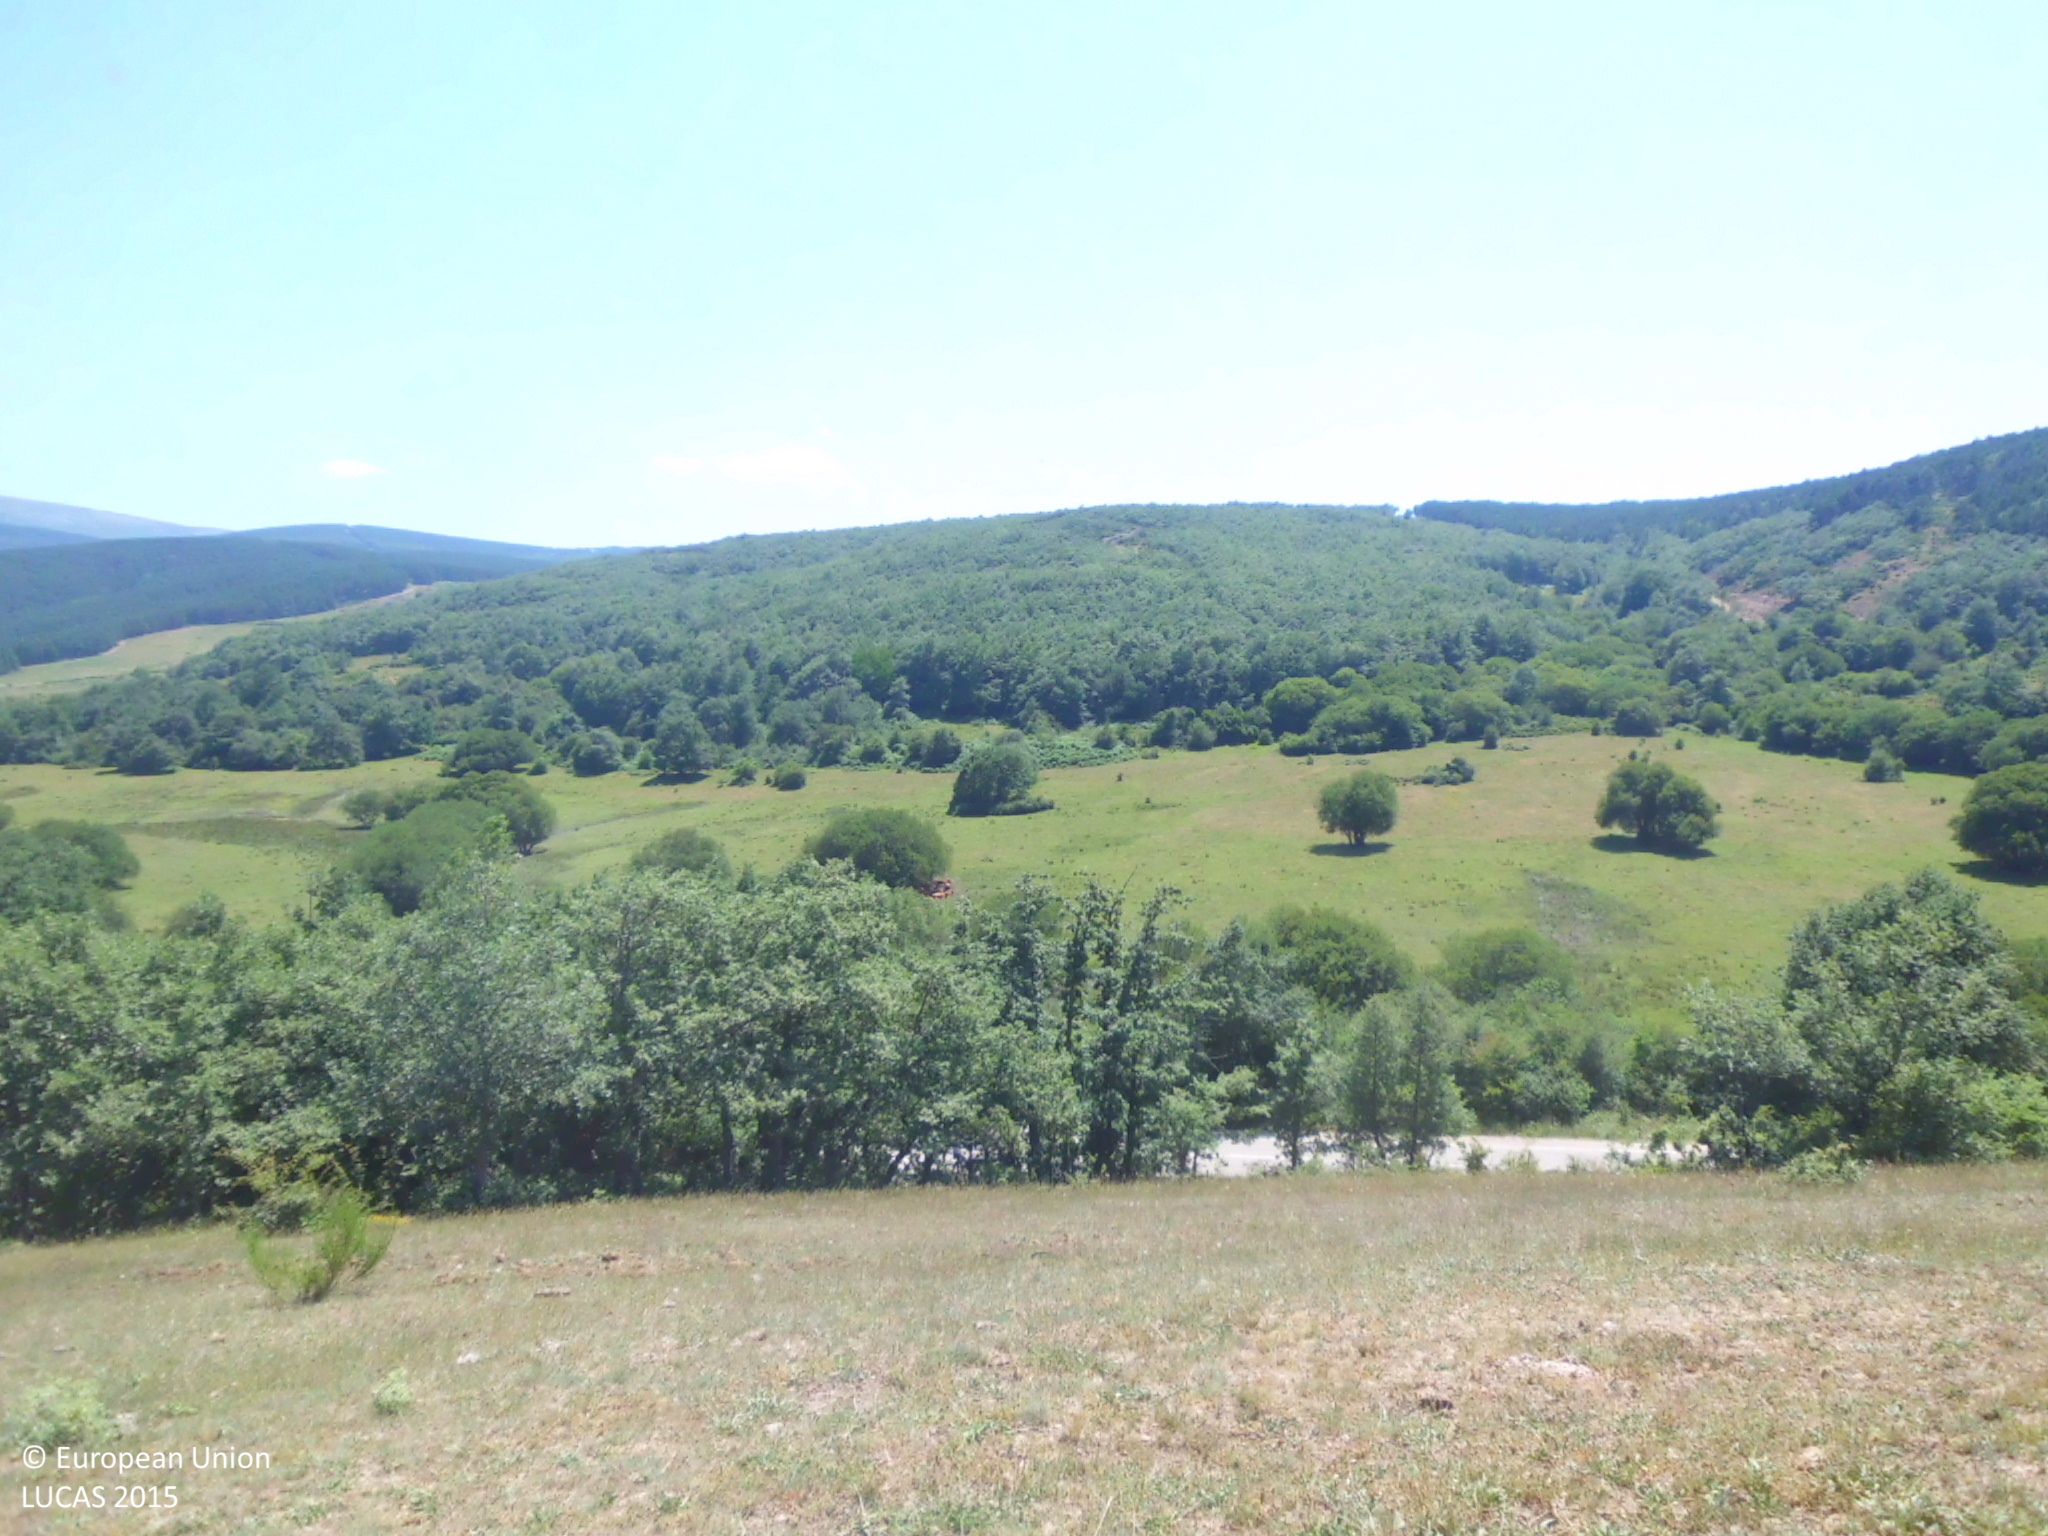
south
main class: Grassland
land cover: Grassland without tree/shrub cover
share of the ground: > 75 %
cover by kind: herbaceous plants 100 %
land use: Agriculture (excluding fallow land and kitchen gardens)
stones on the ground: < 10 %
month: July
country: ES
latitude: 42.3041
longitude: -3.2887
